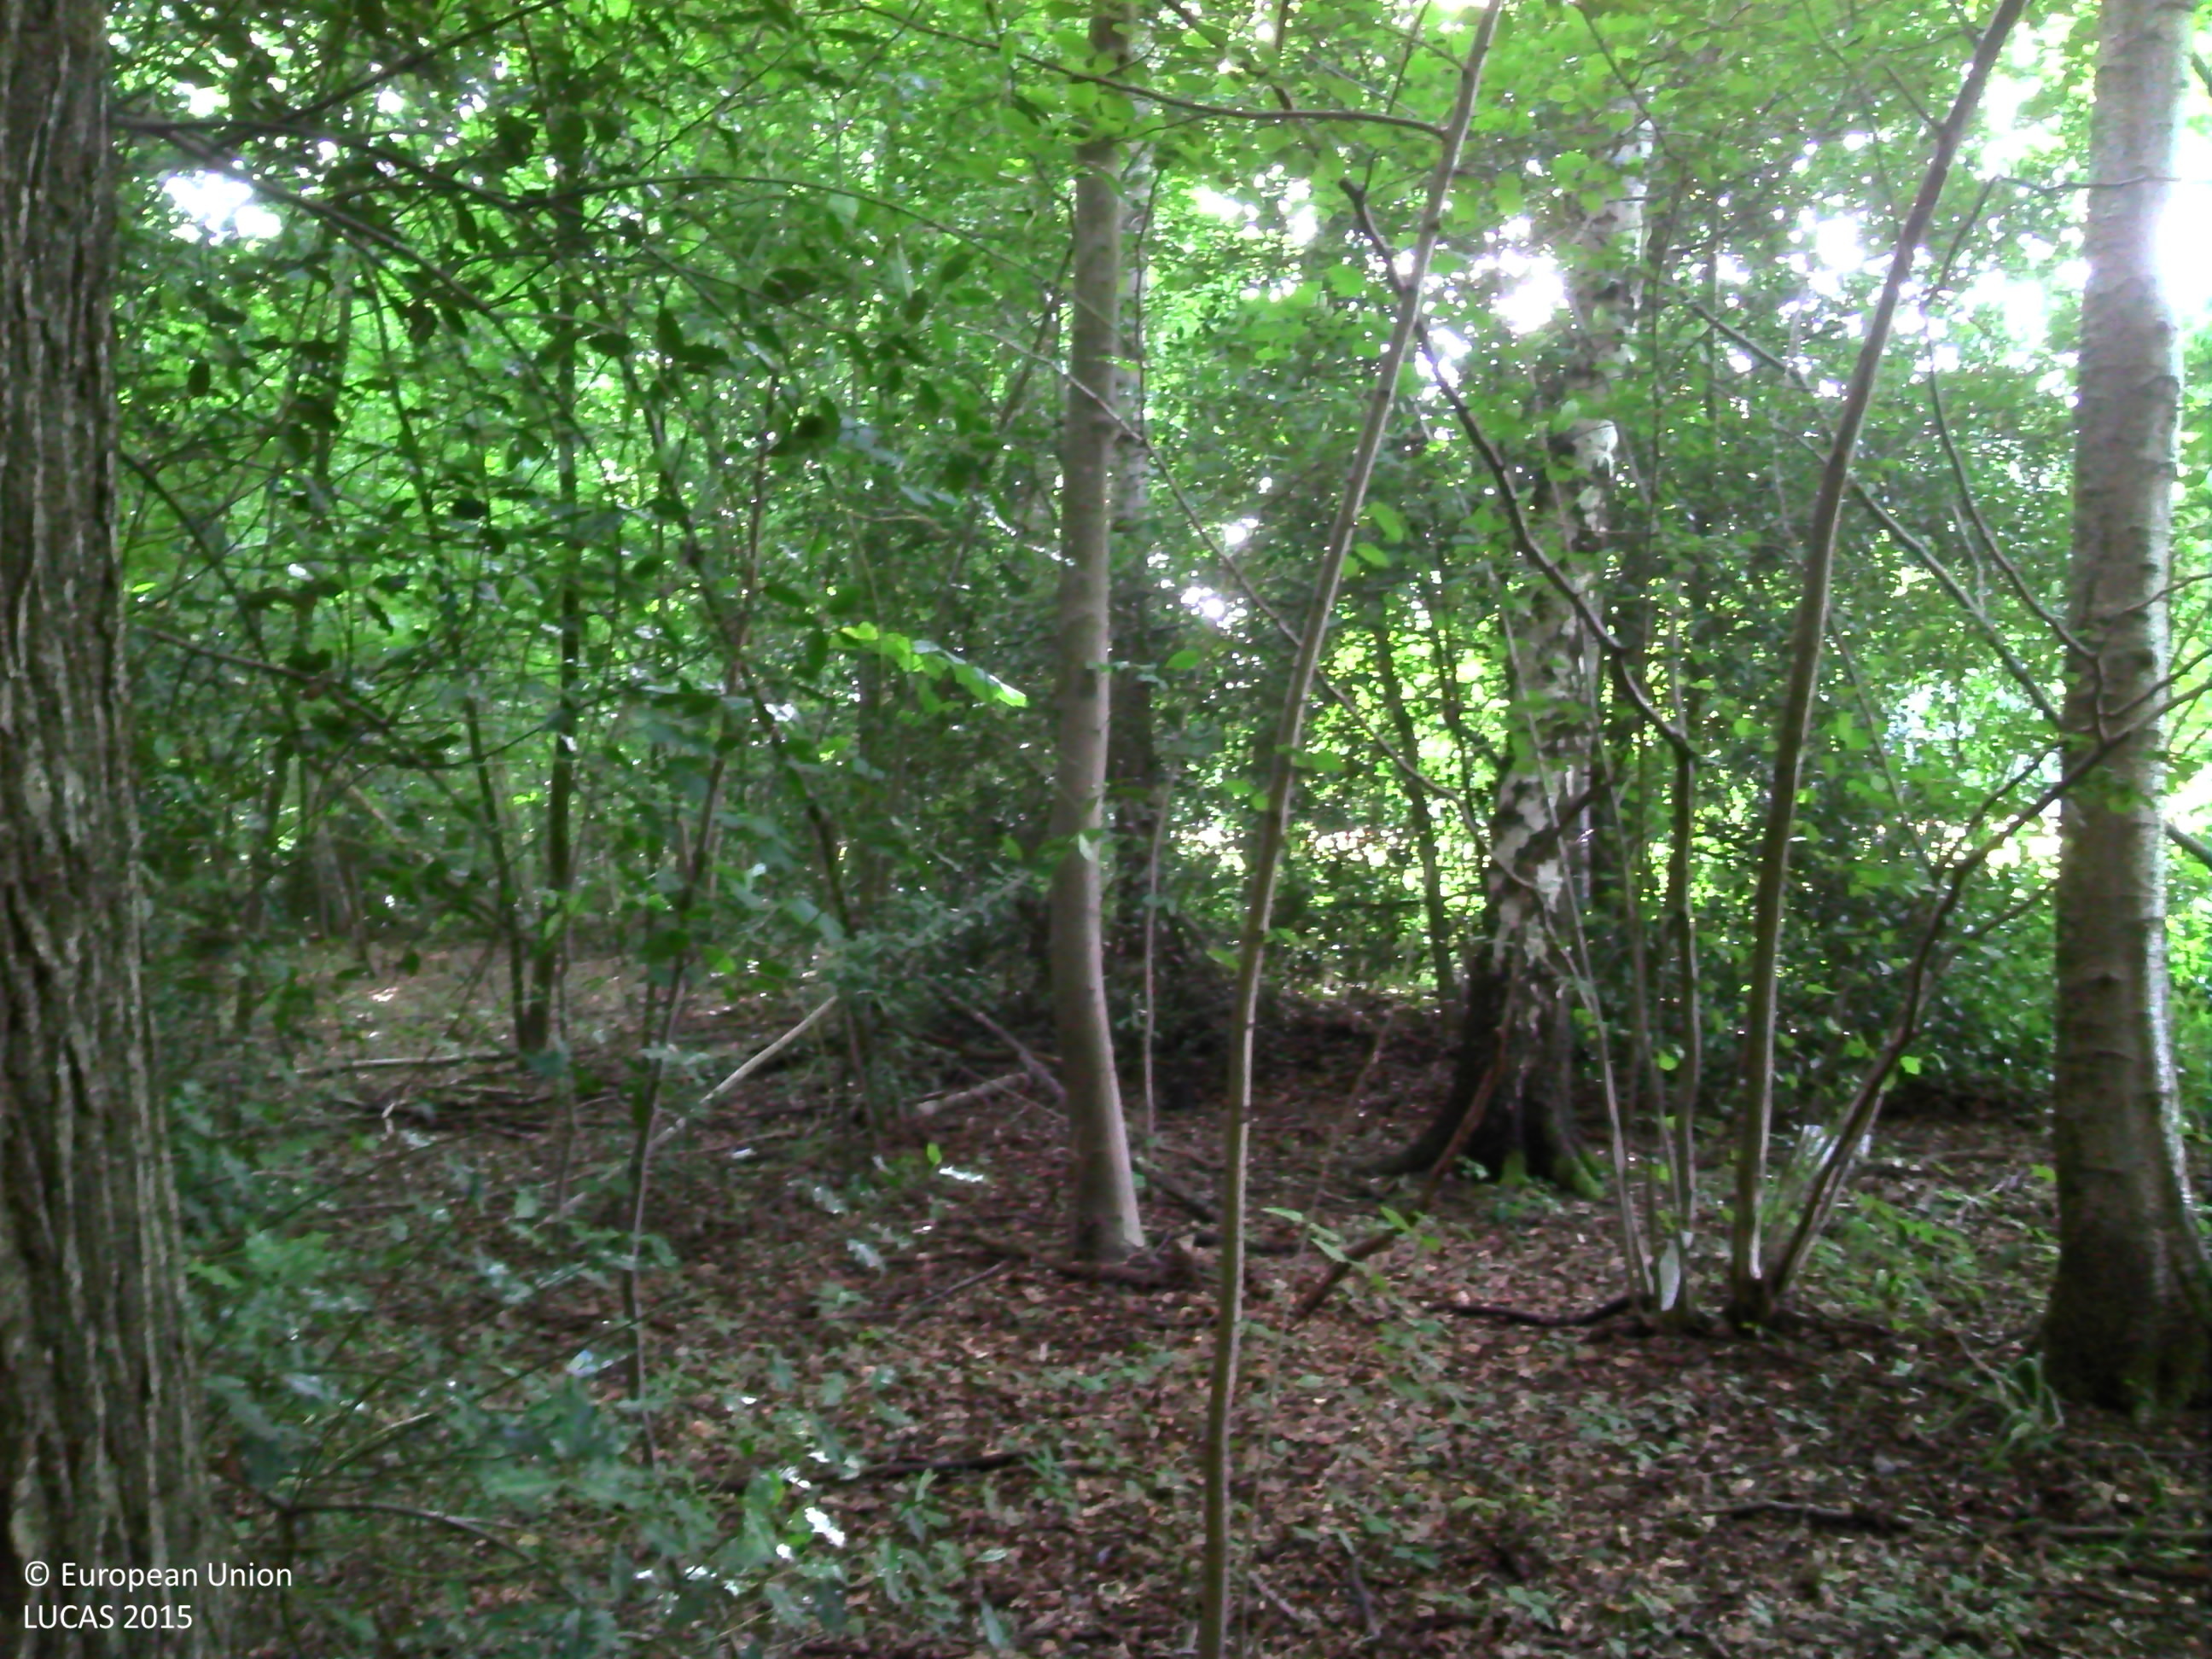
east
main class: Woodland
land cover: Broadleaved woodland
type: acidophilous oak and oak-birch forest
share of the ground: > 75 %
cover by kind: broadleaved forest trees 95 %, herbaceous plants 5 %
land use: Forestry
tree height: > 5 m
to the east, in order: Broadleaved woodland; Fences; Grassland with sparse tree/shrub cover; Lines of trees; Grassland with sparse tree/shrub cover; Fences; Broadleaved woodland
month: July
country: BE
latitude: 50.4804
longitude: 5.2203
